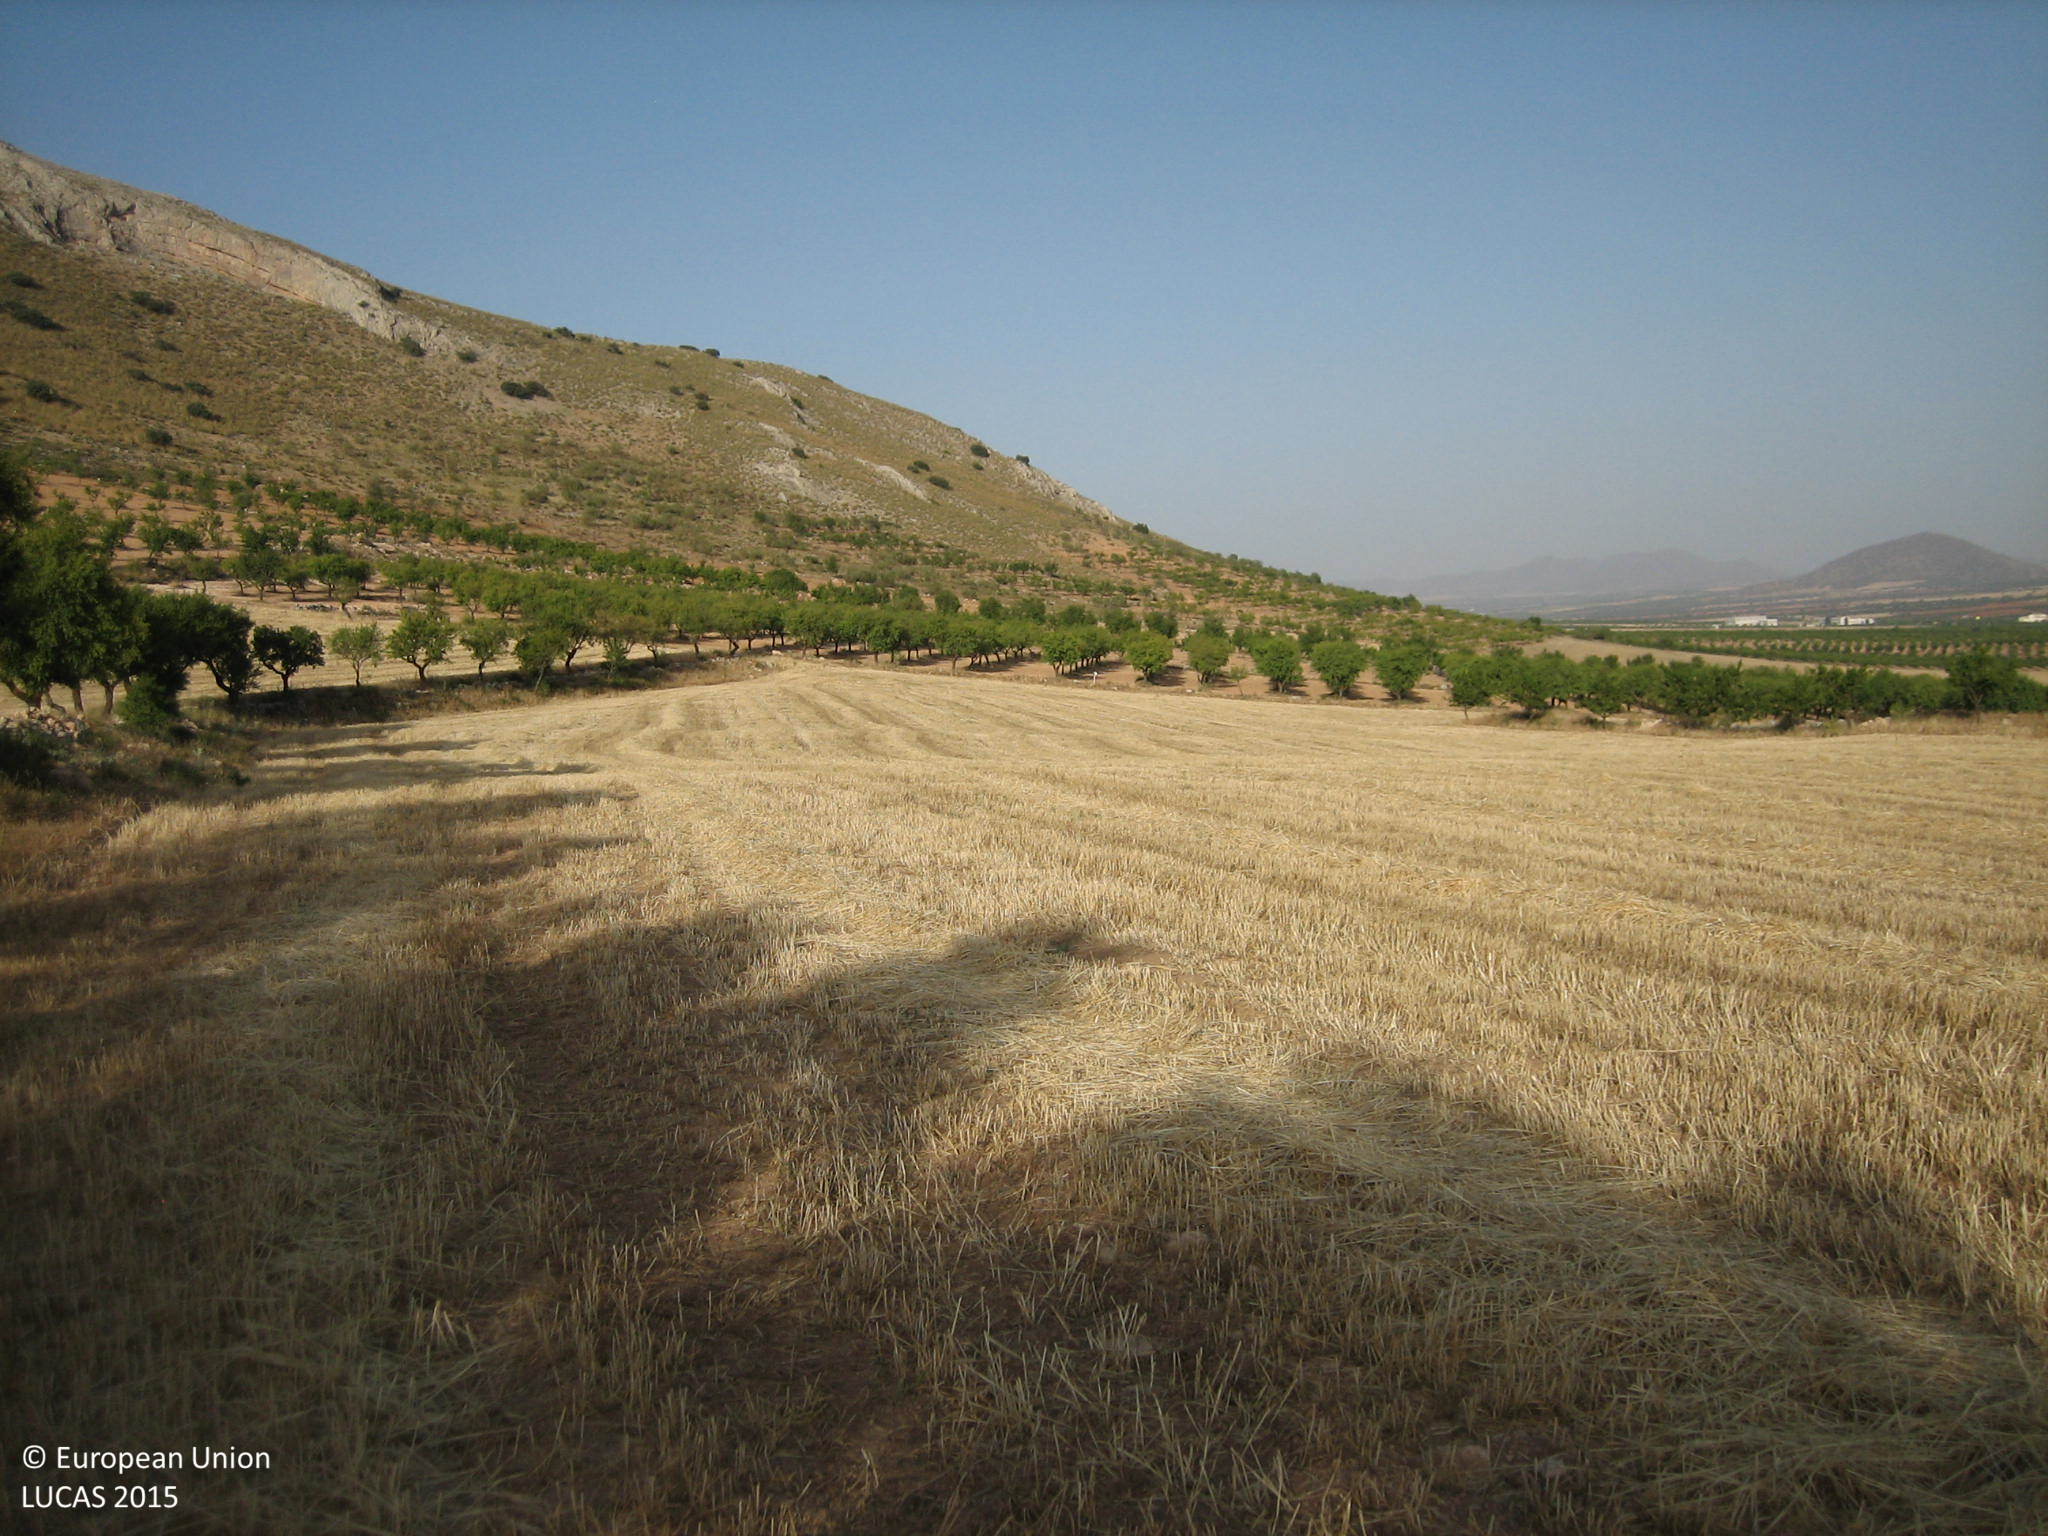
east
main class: Cropland
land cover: Barley
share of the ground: < 10 %
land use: Agriculture (excluding fallow land and kitchen gardens)
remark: Harvested field
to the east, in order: Barley; Grass margins; Nuts trees; Grass margins; Nuts trees
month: July
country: ES
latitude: 37.6118
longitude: -2.3907
